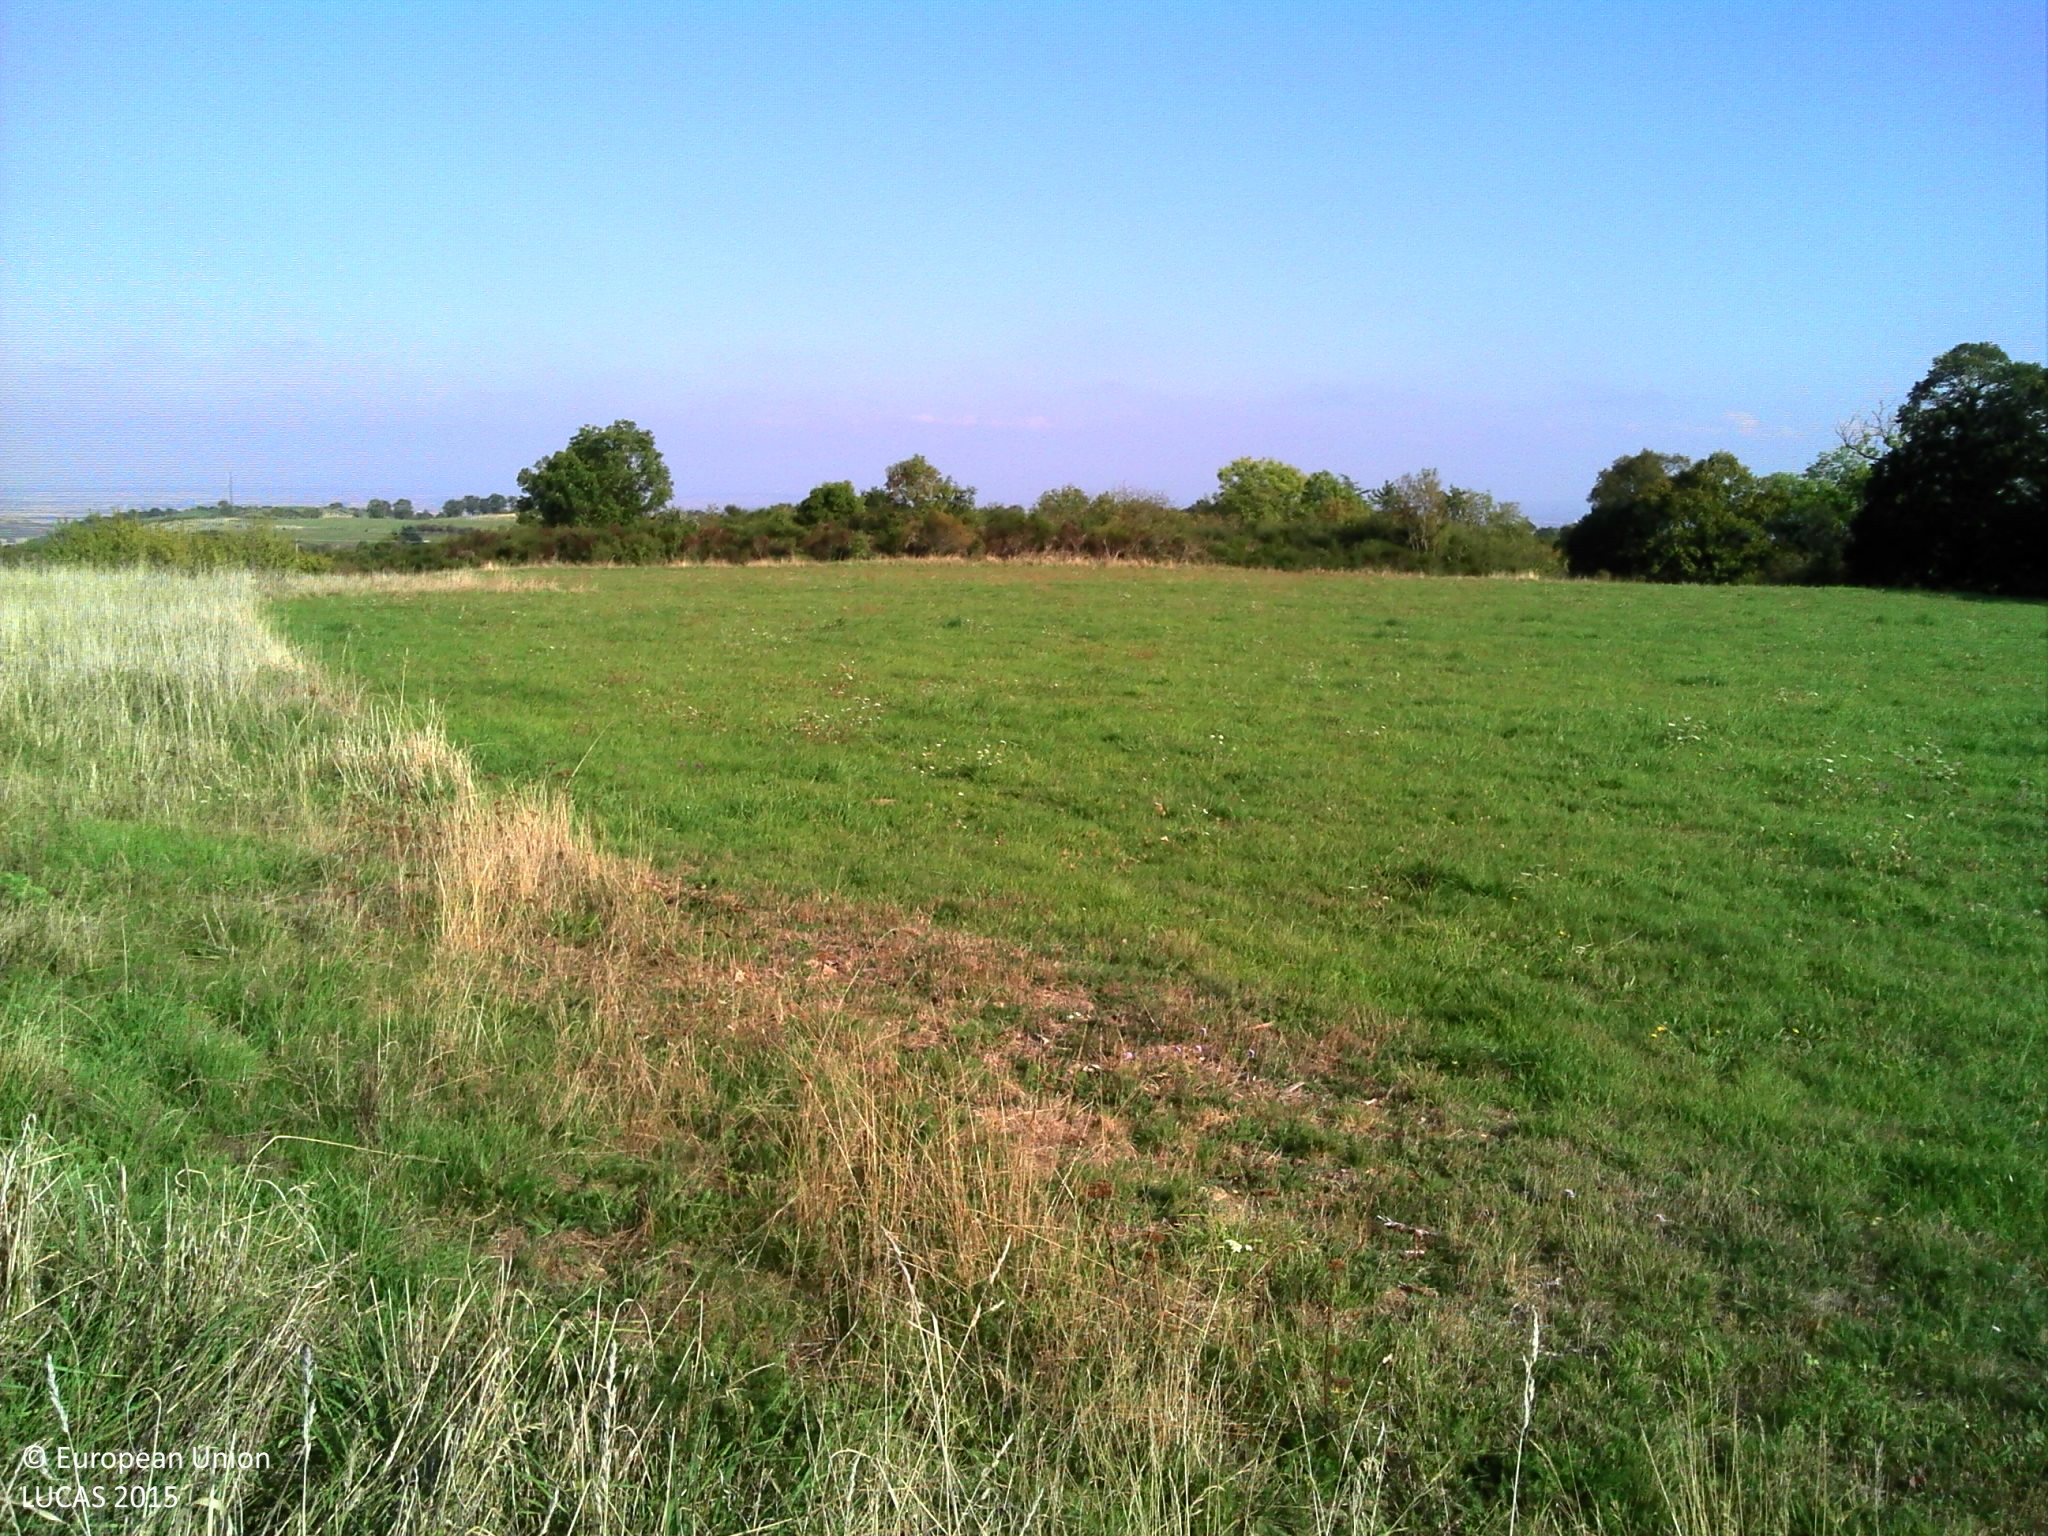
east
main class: Grassland
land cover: Grassland without tree/shrub cover
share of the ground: > 75 %
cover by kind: herbaceous plants 100 %
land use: Agriculture (excluding fallow land and kitchen gardens)
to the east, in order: Grassland without tree/shrub cover; Shrubland without tree cover; Grassland without tree/shrub cover; Managed hedges; Fences; Ditches and canals; Grass margins; Paved roads, cycling and walking lanes; Grass margins; Ditches and canals; Spontaneously vegetated surfaces; Electric lines; Fences; Shrubland without tree cover; Broadleaved woodland
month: October
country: FR
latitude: 45.9619
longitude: 3.0439
